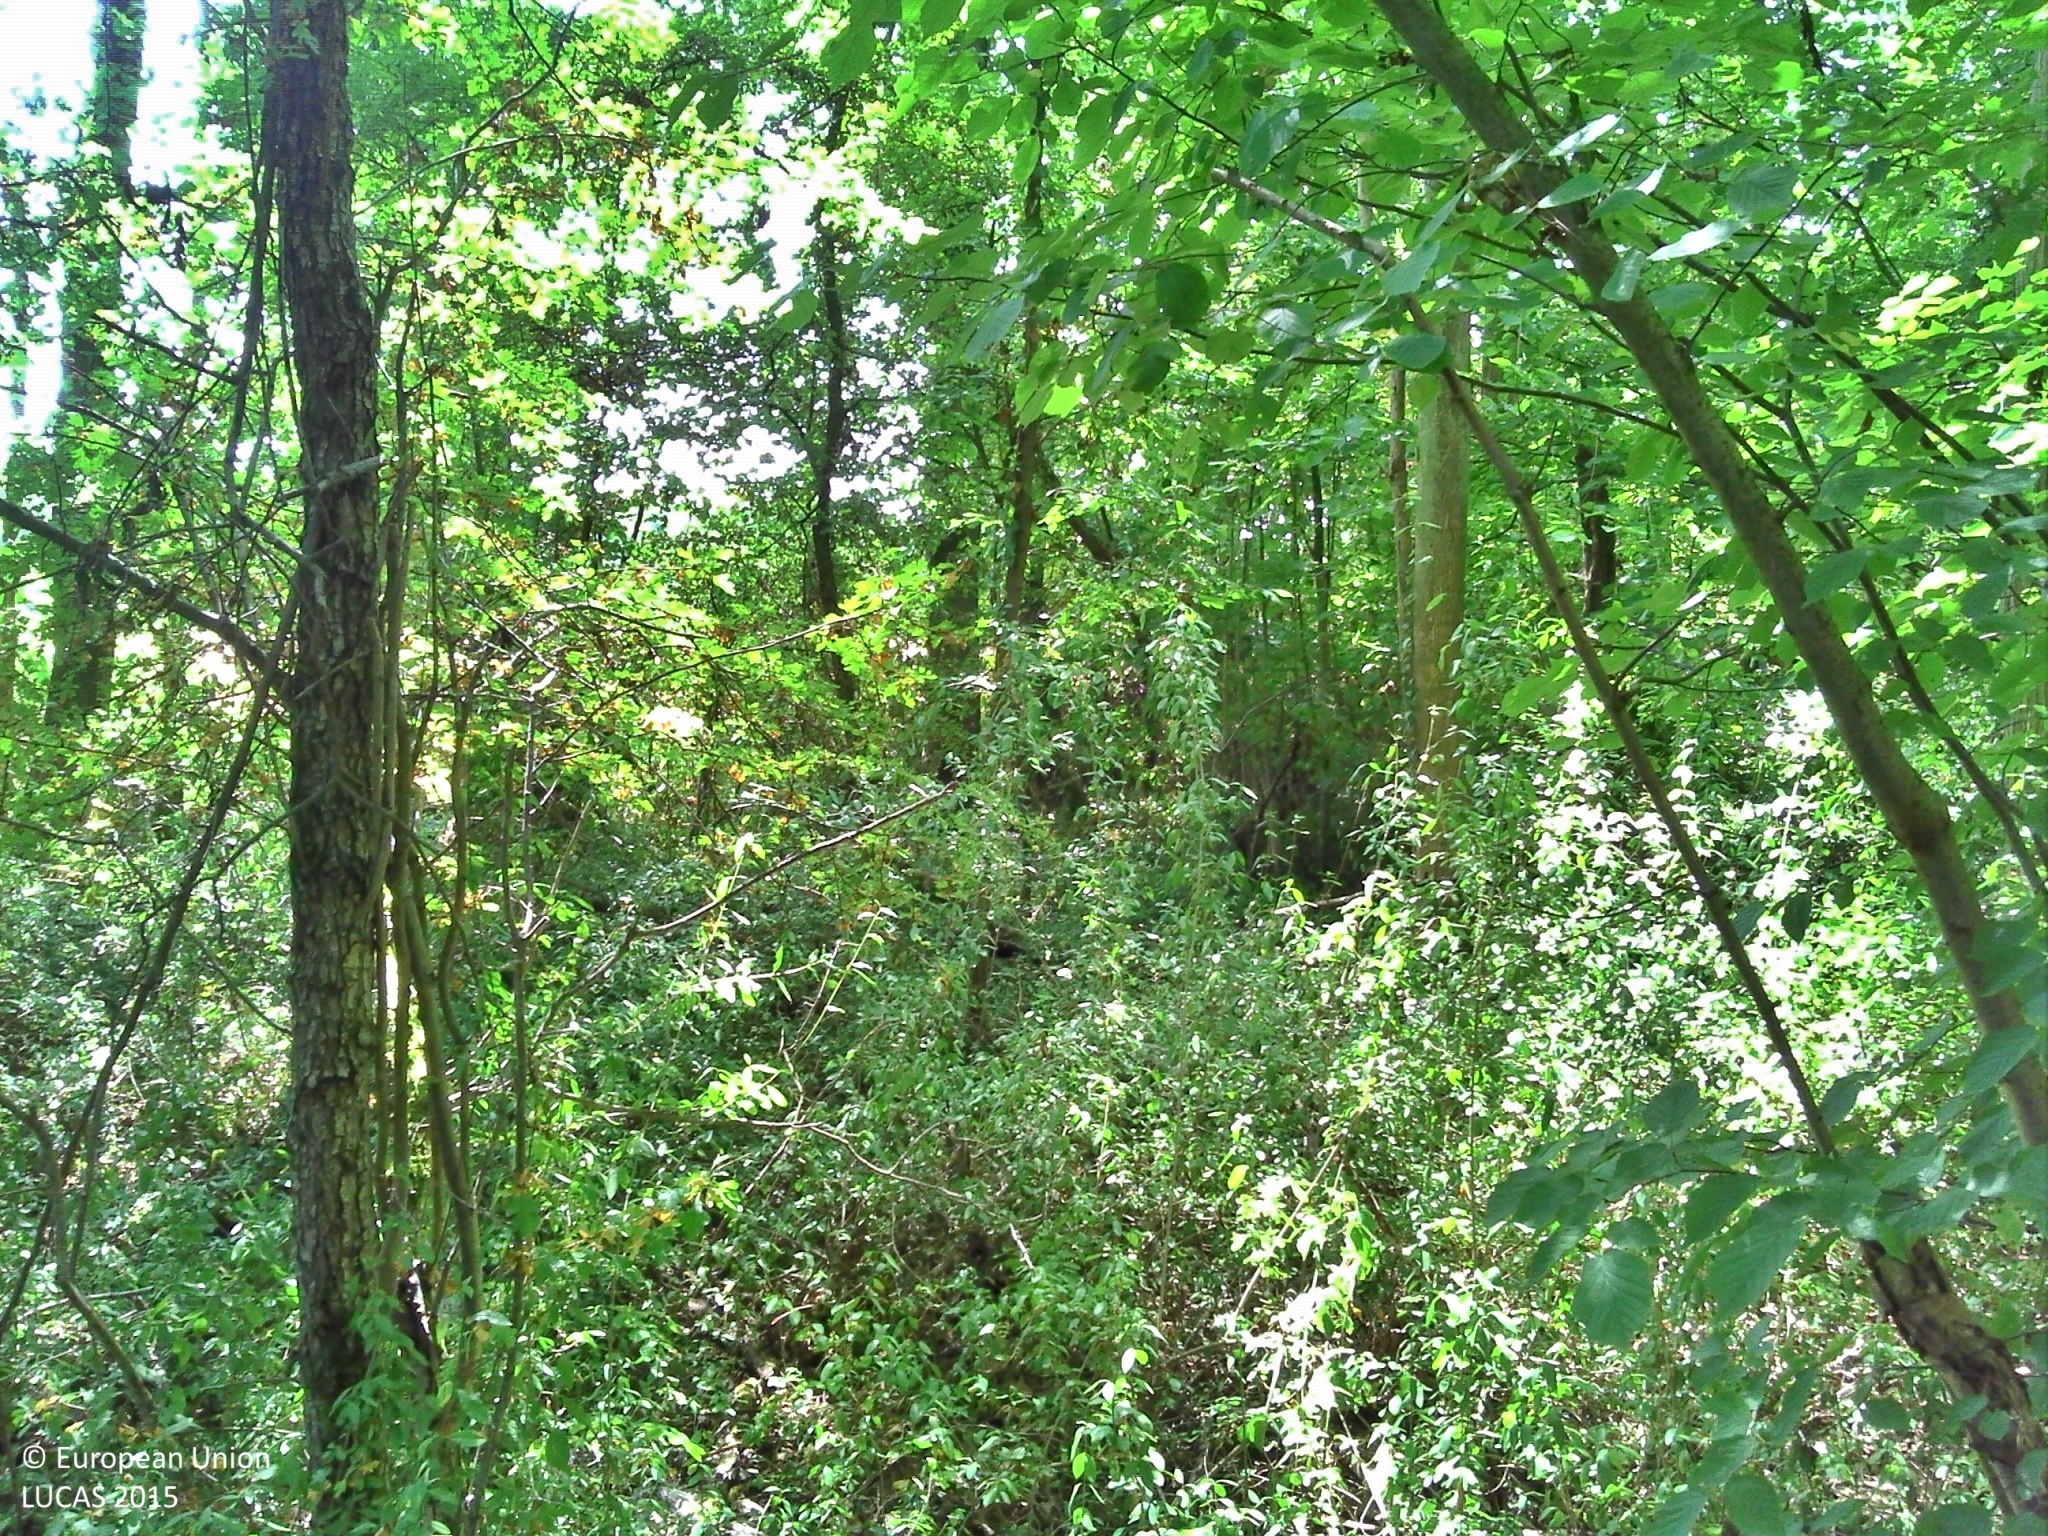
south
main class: Woodland
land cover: Broadleaved woodland
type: mesophytic deciduous forest
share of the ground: > 75 %
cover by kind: broadleaved forest trees 80 %, shrubs 10 %, herbaceous plants 10 %
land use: Forestry
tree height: > 5 m
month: July
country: FR
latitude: 49.2236
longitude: 2.3670
